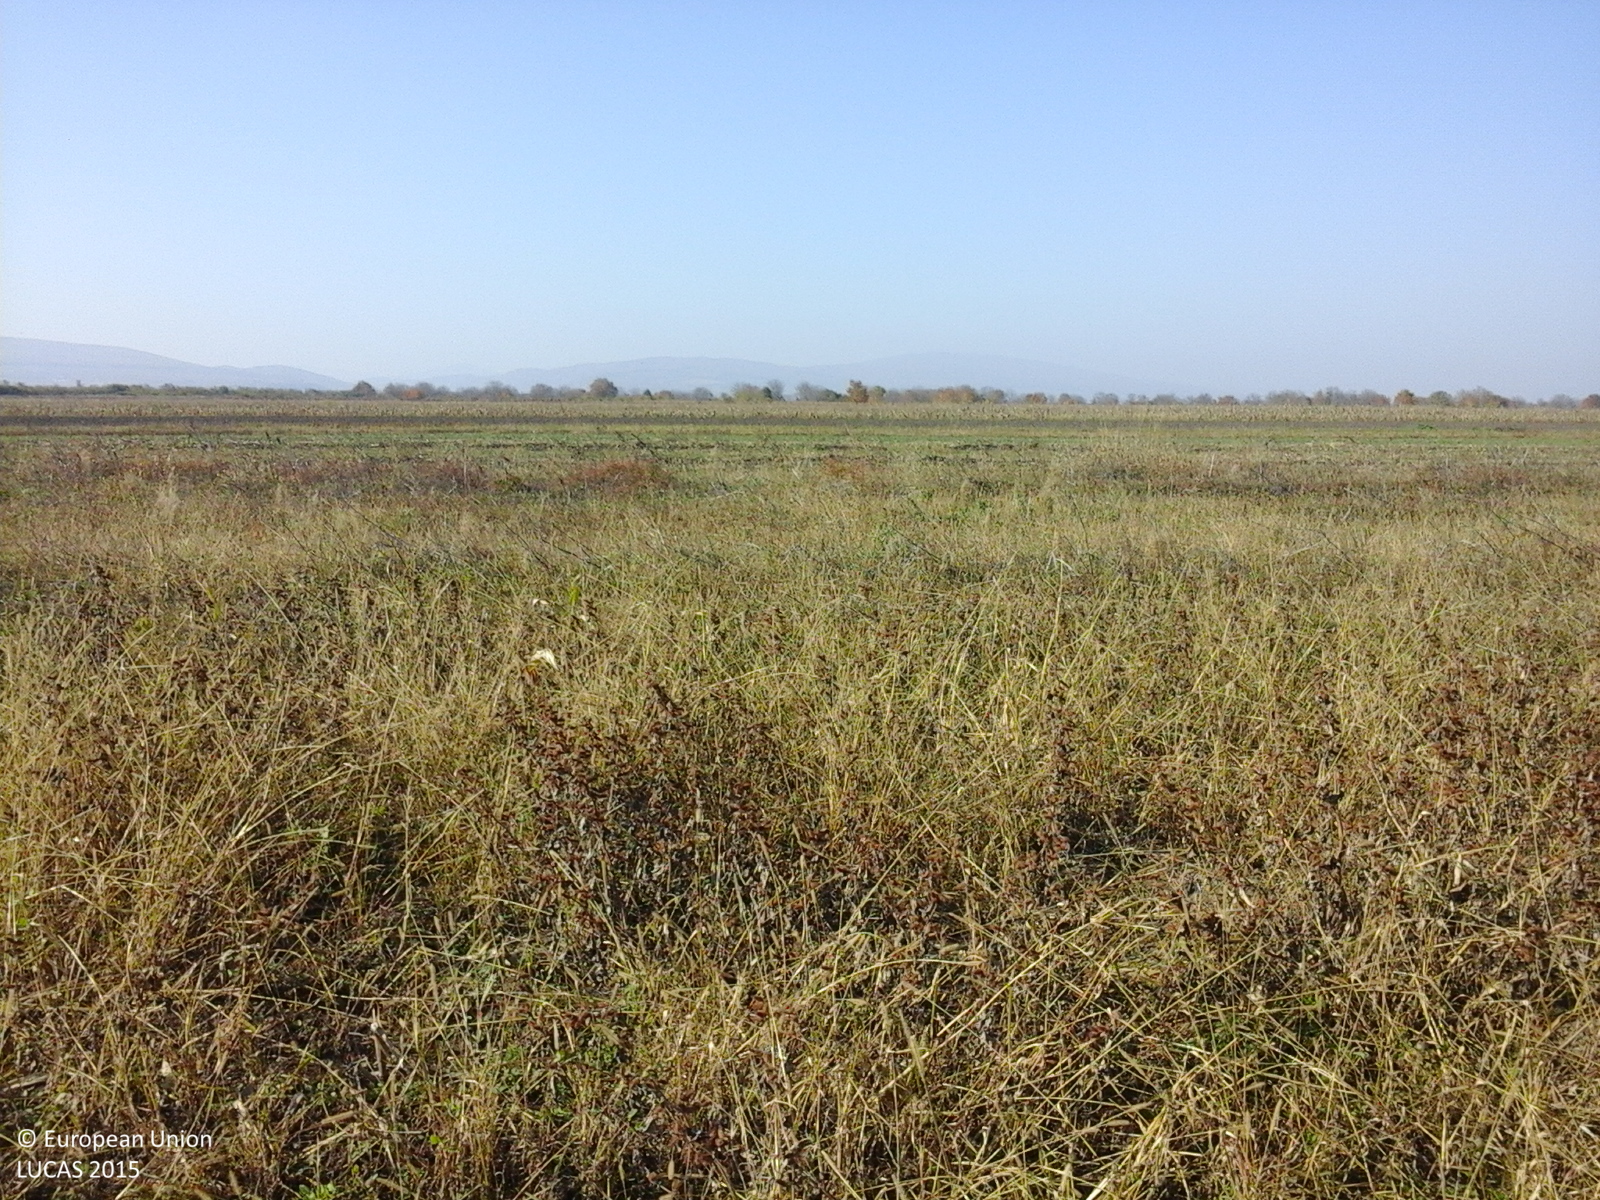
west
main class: Cropland
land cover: Maize
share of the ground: 25 - 50 %
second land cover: Spontaneously vegetated surfaces
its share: > 75 %
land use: Agriculture (excluding fallow land and kitchen gardens)
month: October
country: RO
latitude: 45.7263
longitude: 27.1448
